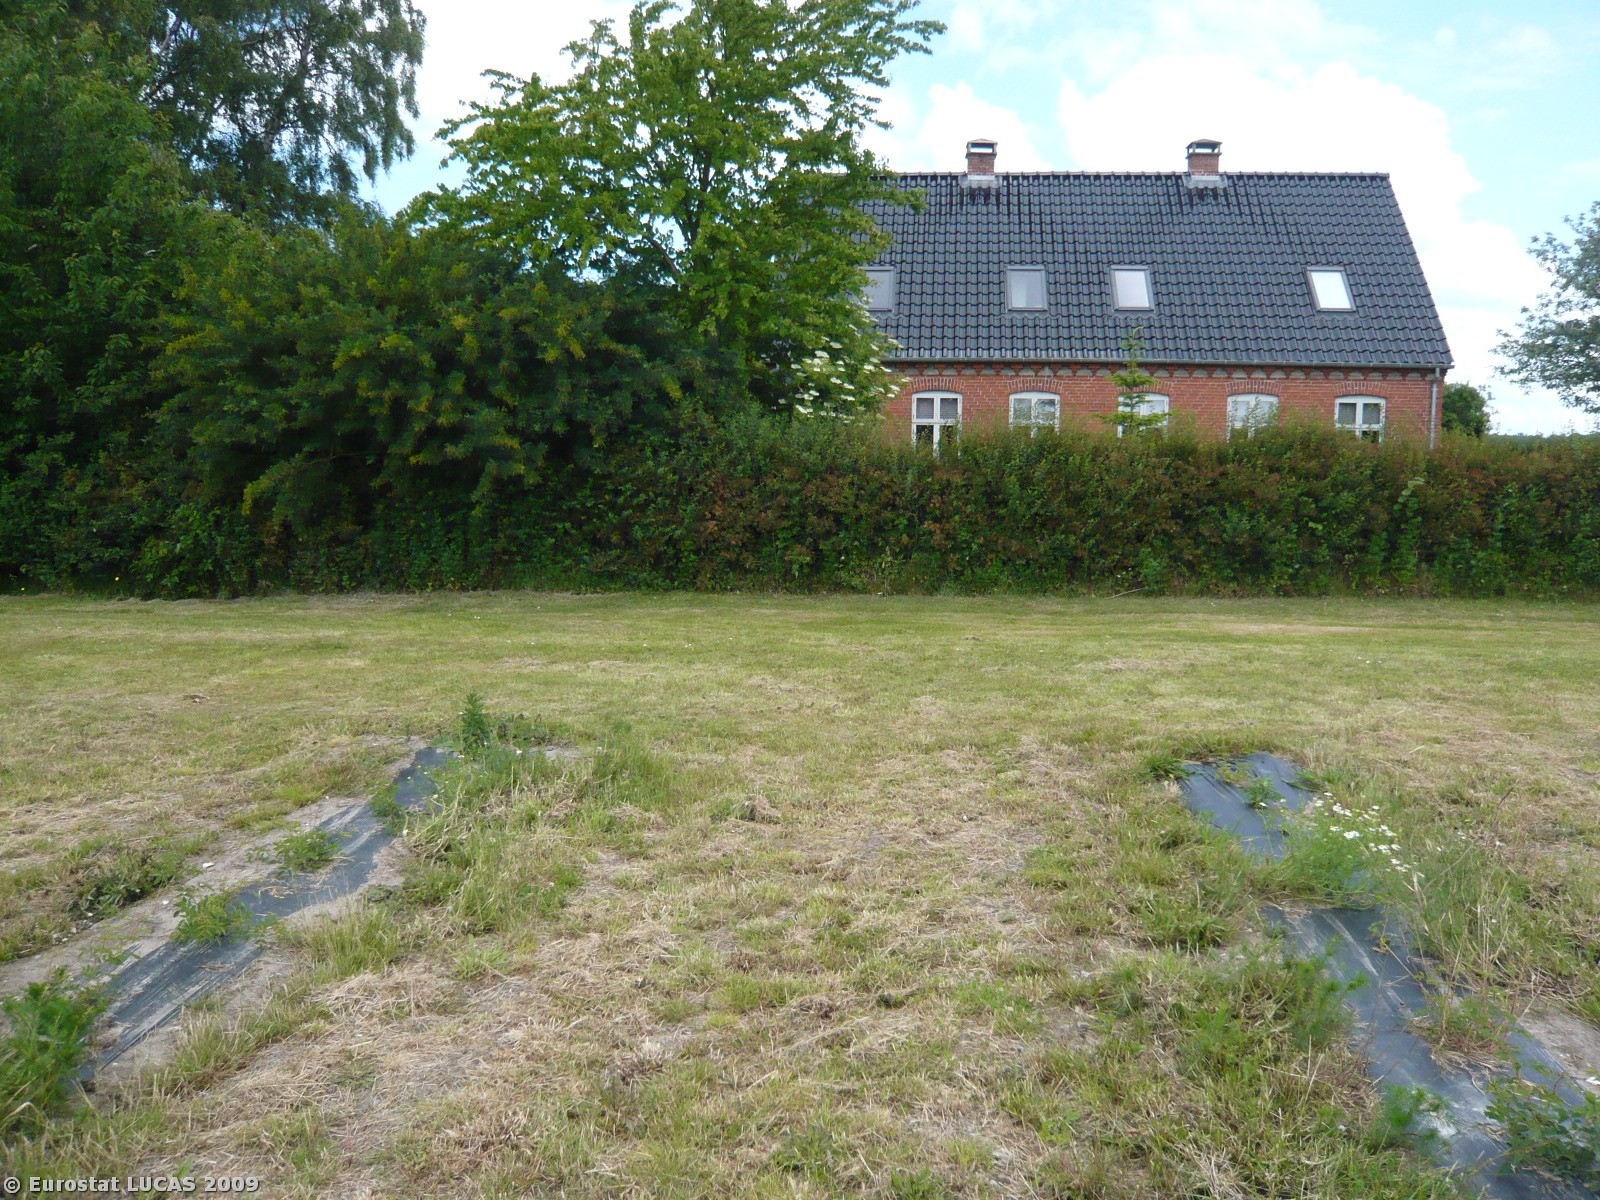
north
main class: Cropland
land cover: Common wheat
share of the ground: 10 - 25 %
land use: Agriculture (excluding fallow land and kitchen gardens)
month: June
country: DK
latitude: 54.7572
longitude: 11.6305
